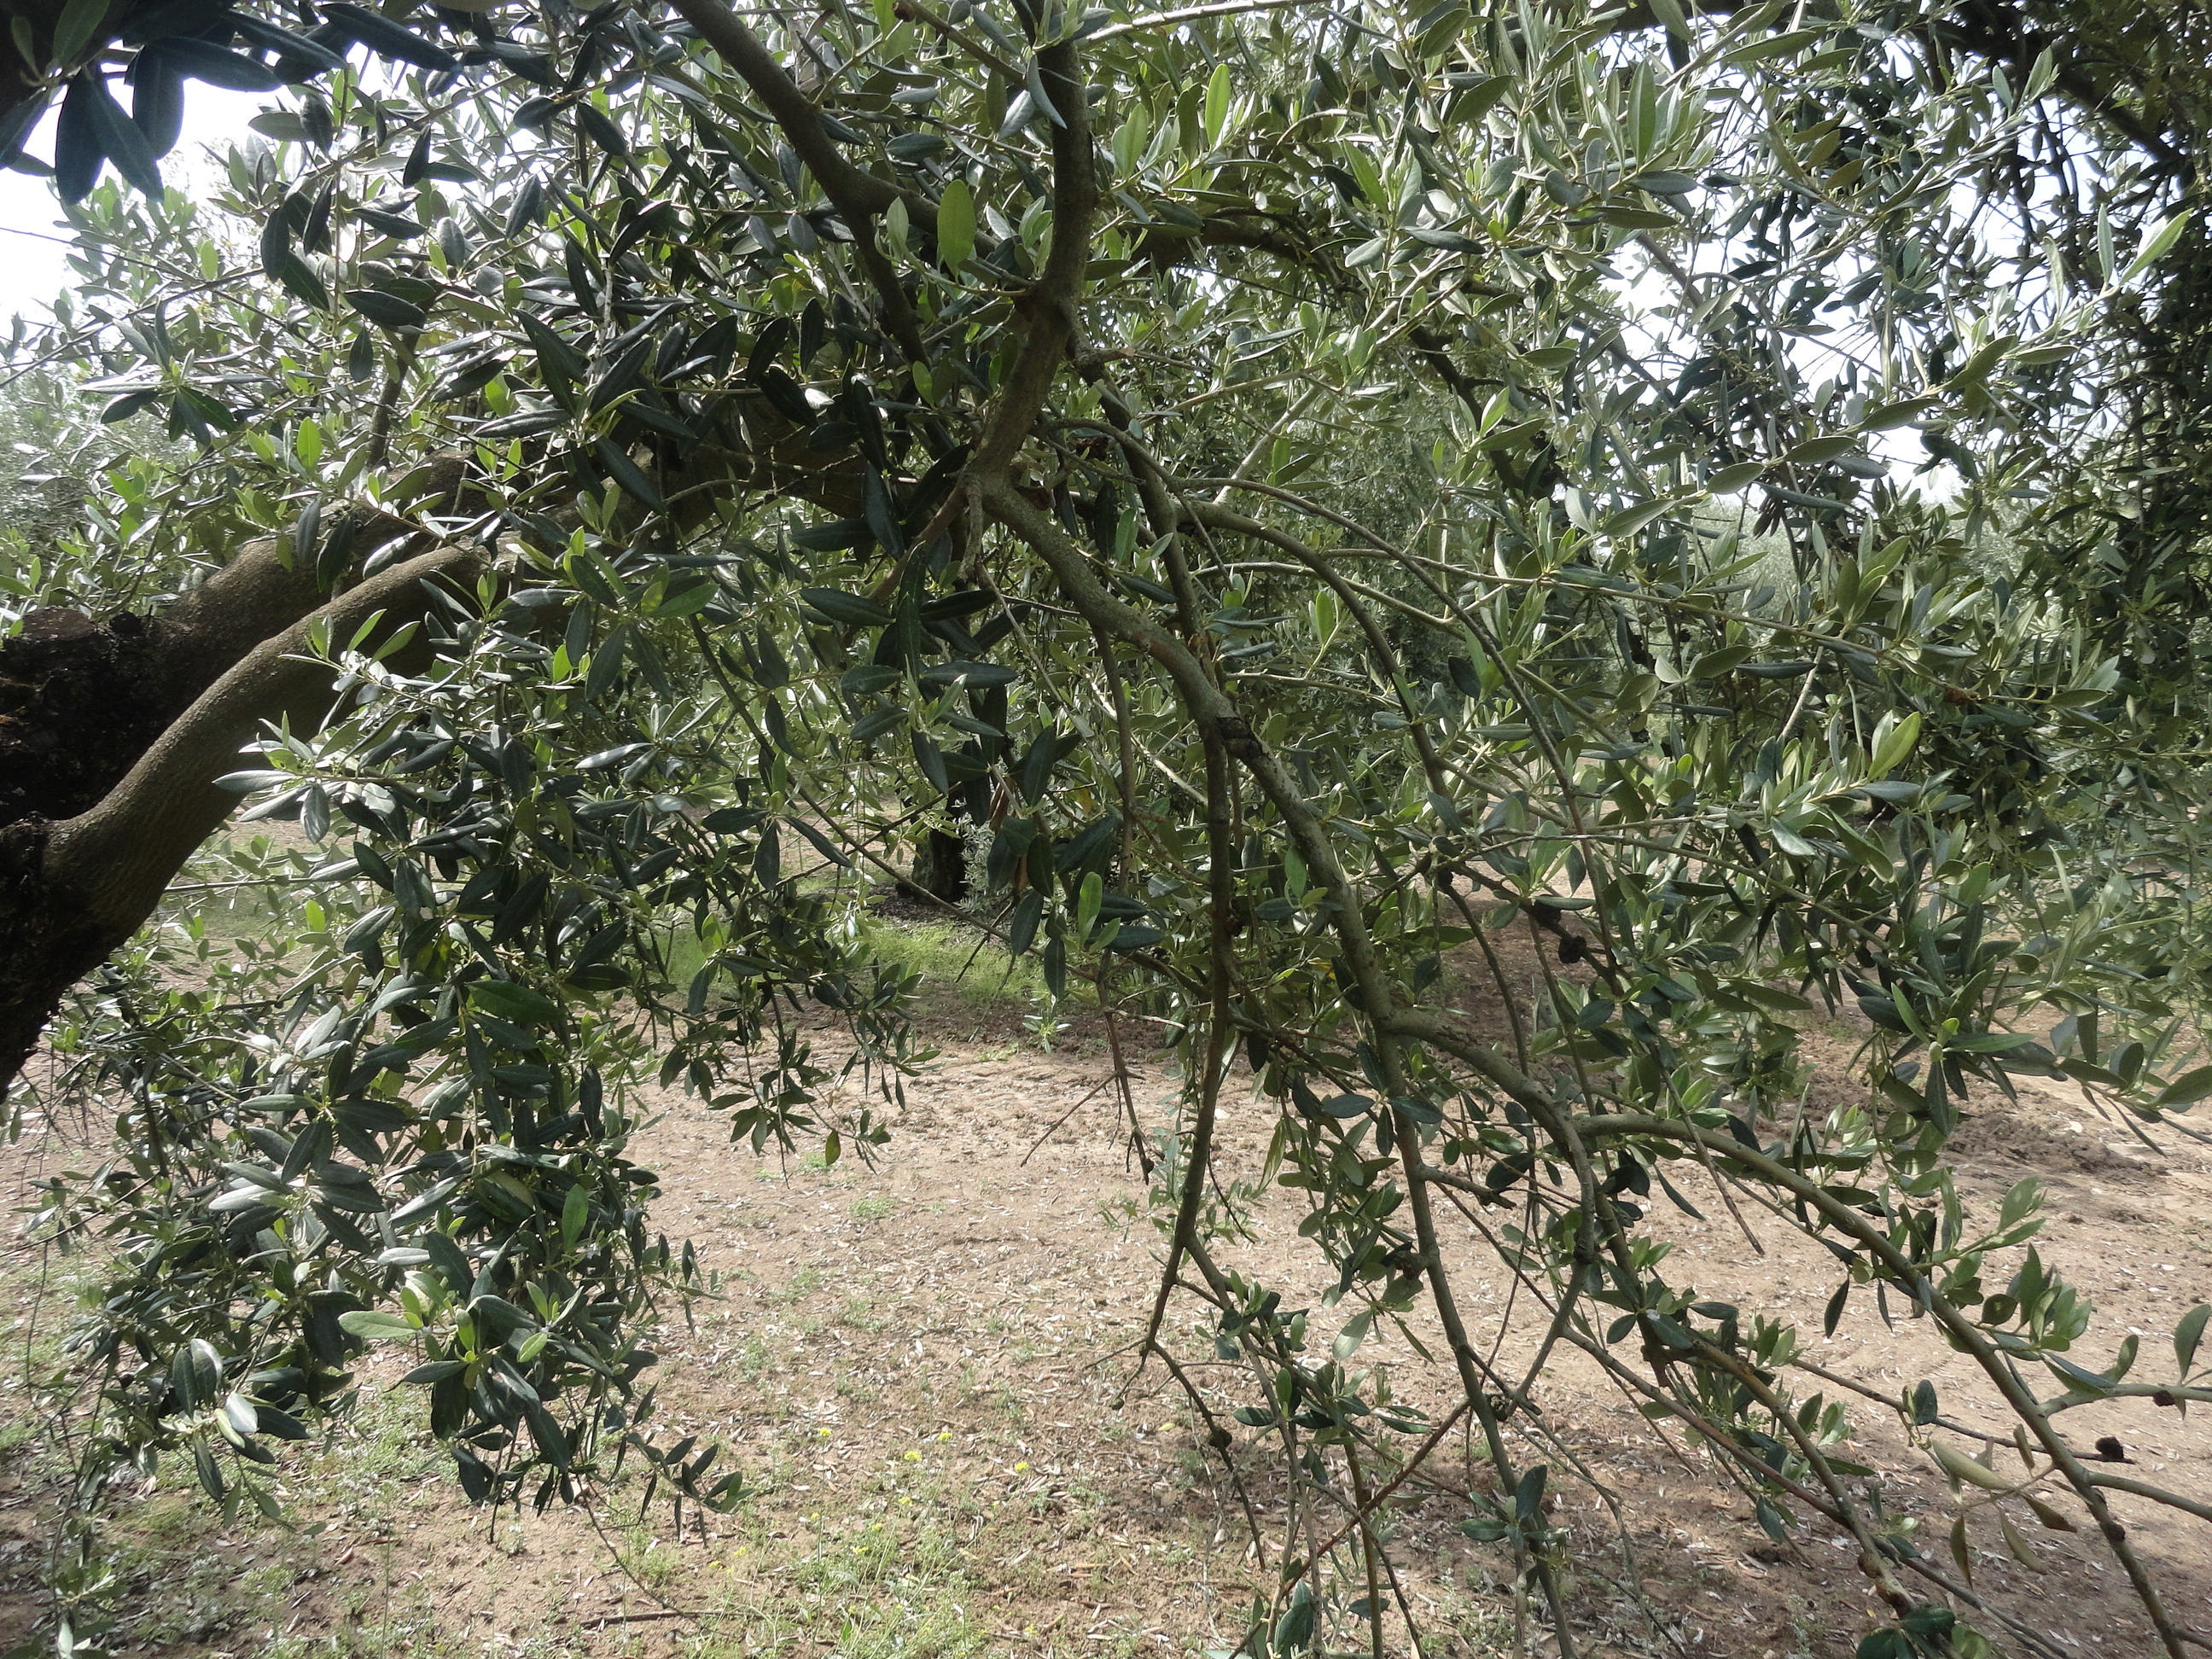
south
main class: Cropland
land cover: Olive groves
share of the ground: 50 - 75 %
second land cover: Spontaneously vegetated surfaces
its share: 10 - 25 %
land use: Agriculture (excluding fallow land and kitchen gardens)
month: April
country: ES
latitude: 37.5347
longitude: -4.5934
